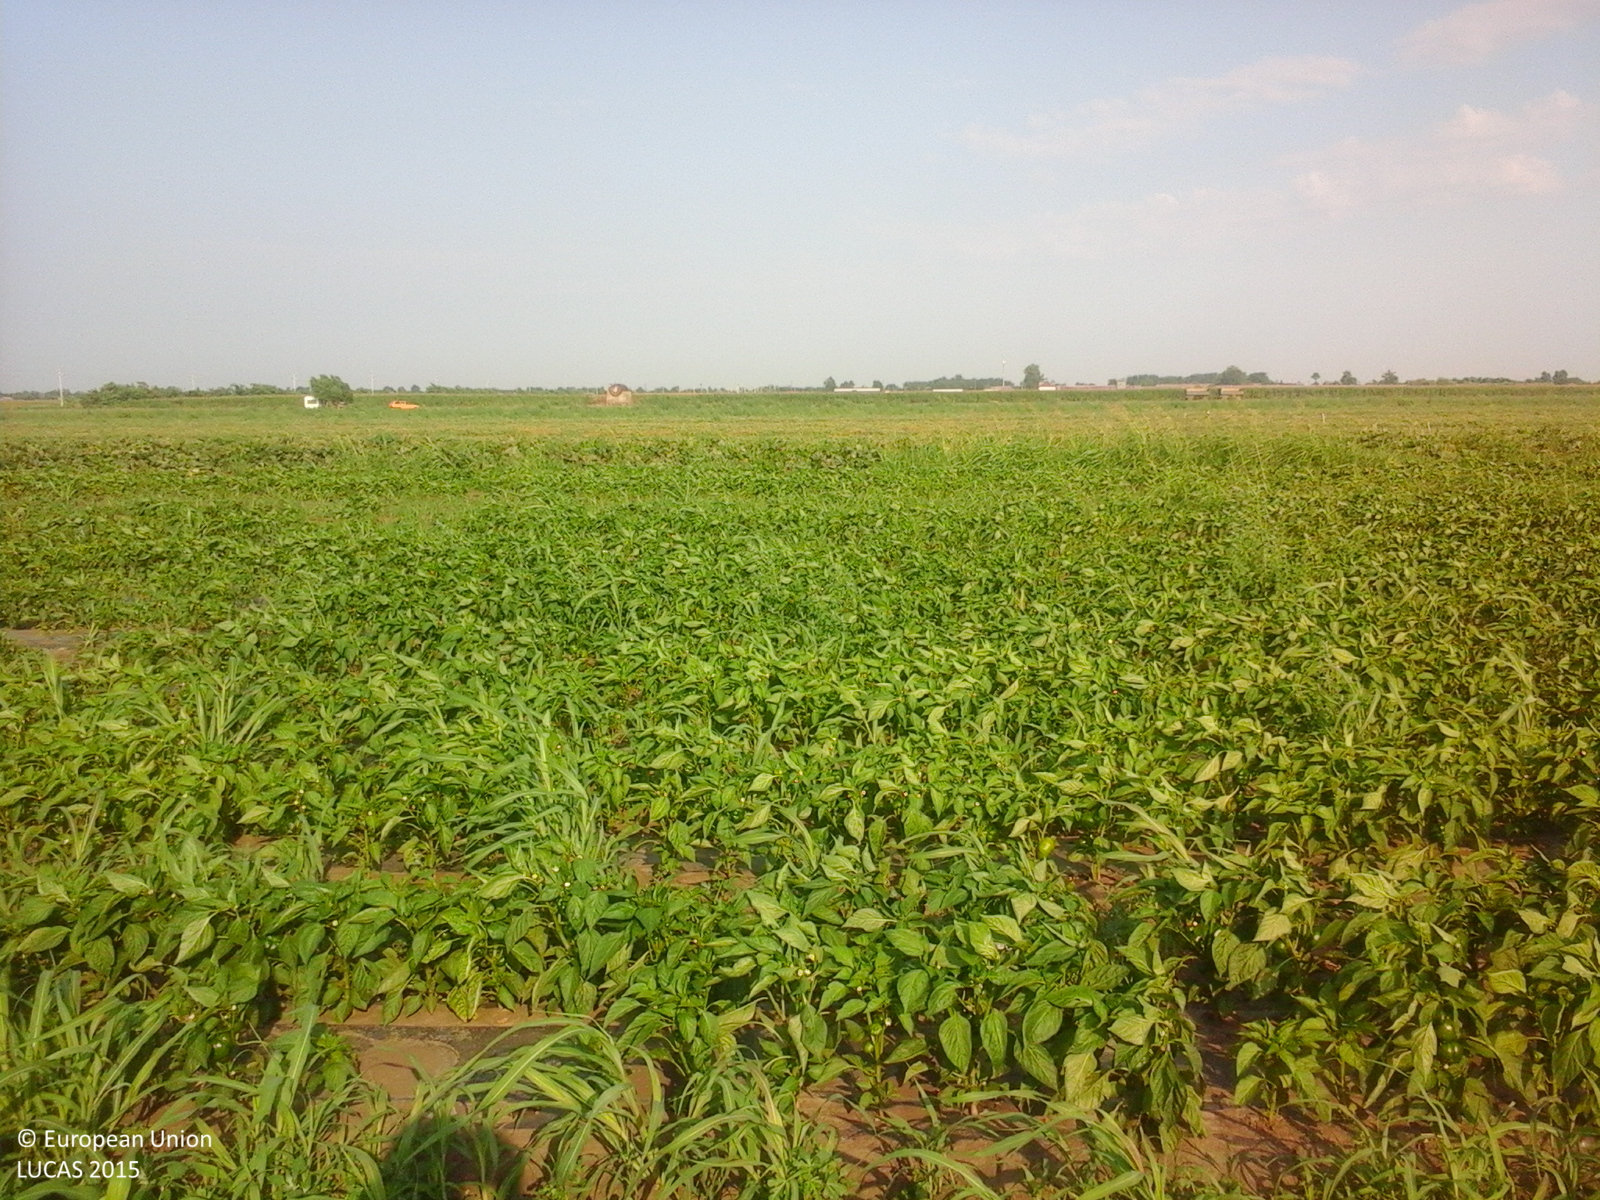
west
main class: Cropland
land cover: Other fresh vegetables
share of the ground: > 75 %
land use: Agriculture (excluding fallow land and kitchen gardens)
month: July
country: RO
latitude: 44.6114
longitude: 27.2102
